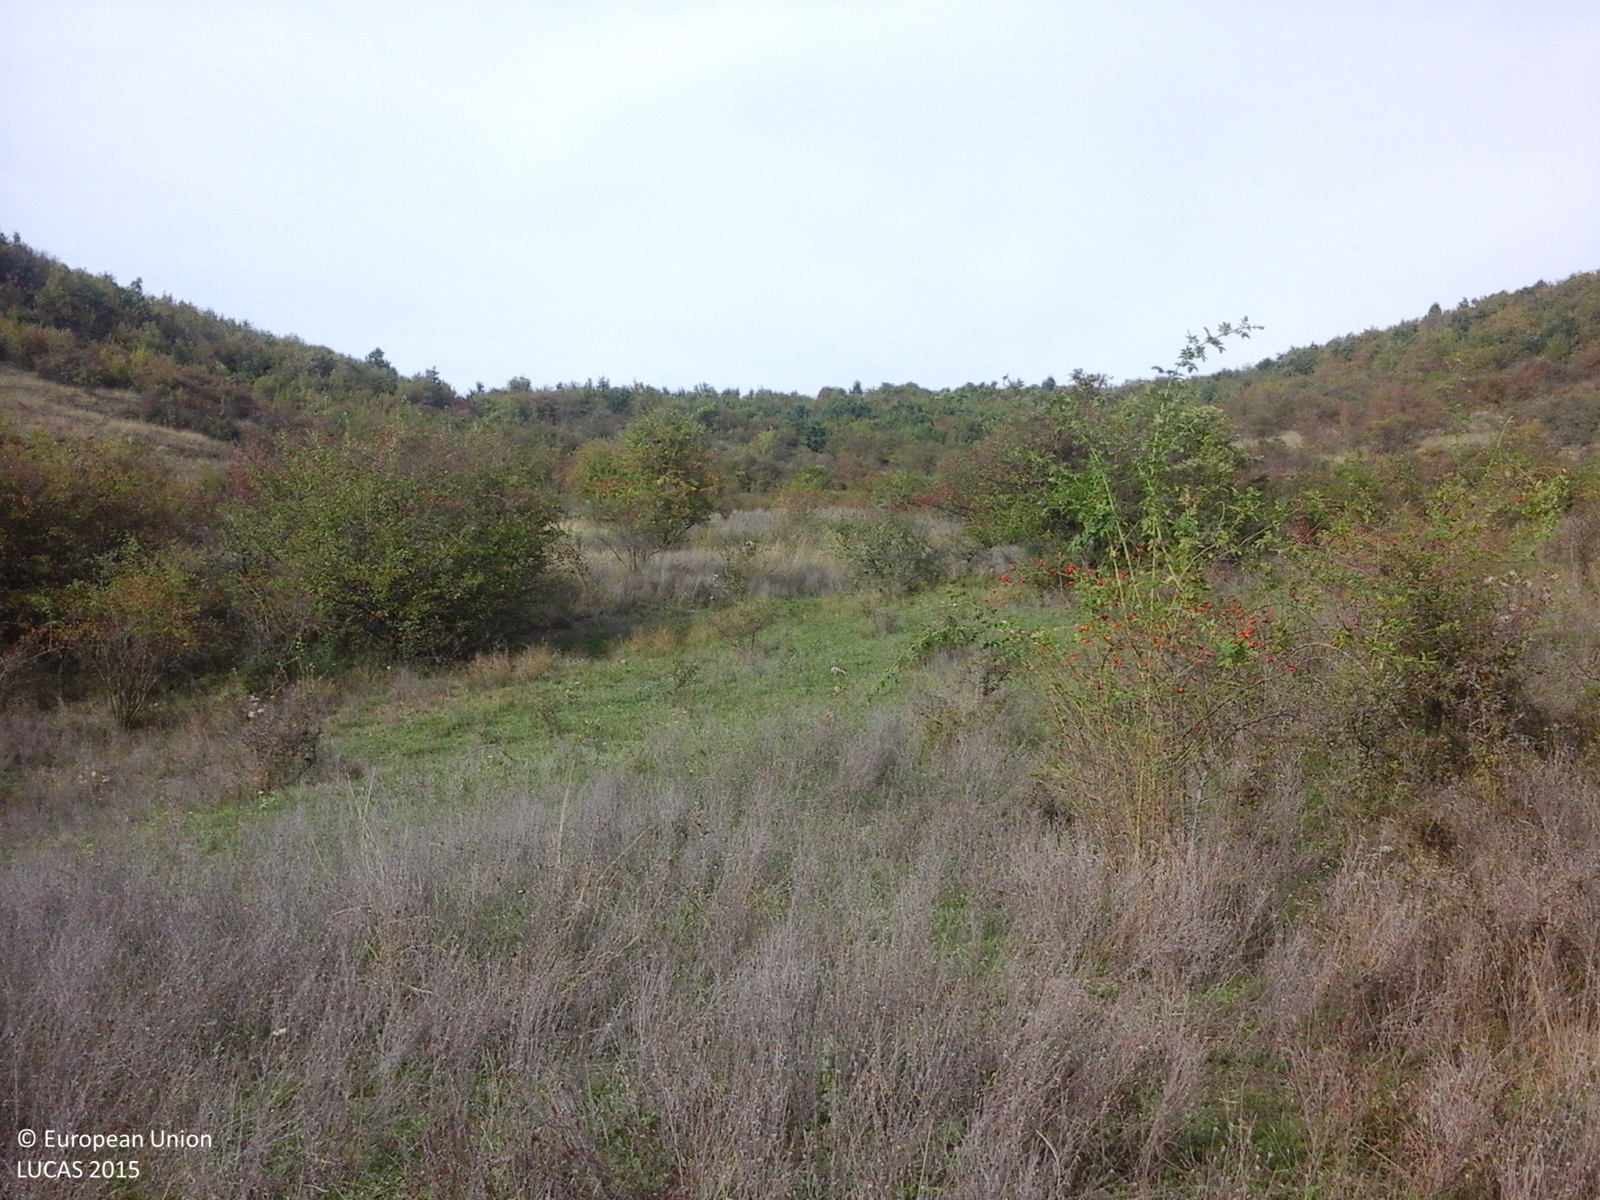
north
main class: Grassland
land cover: Spontaneously vegetated surfaces
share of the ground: > 75 %
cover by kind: herbaceous plants 100 %
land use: Fallow land
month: September
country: RO
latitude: 47.1287
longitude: 23.9617
